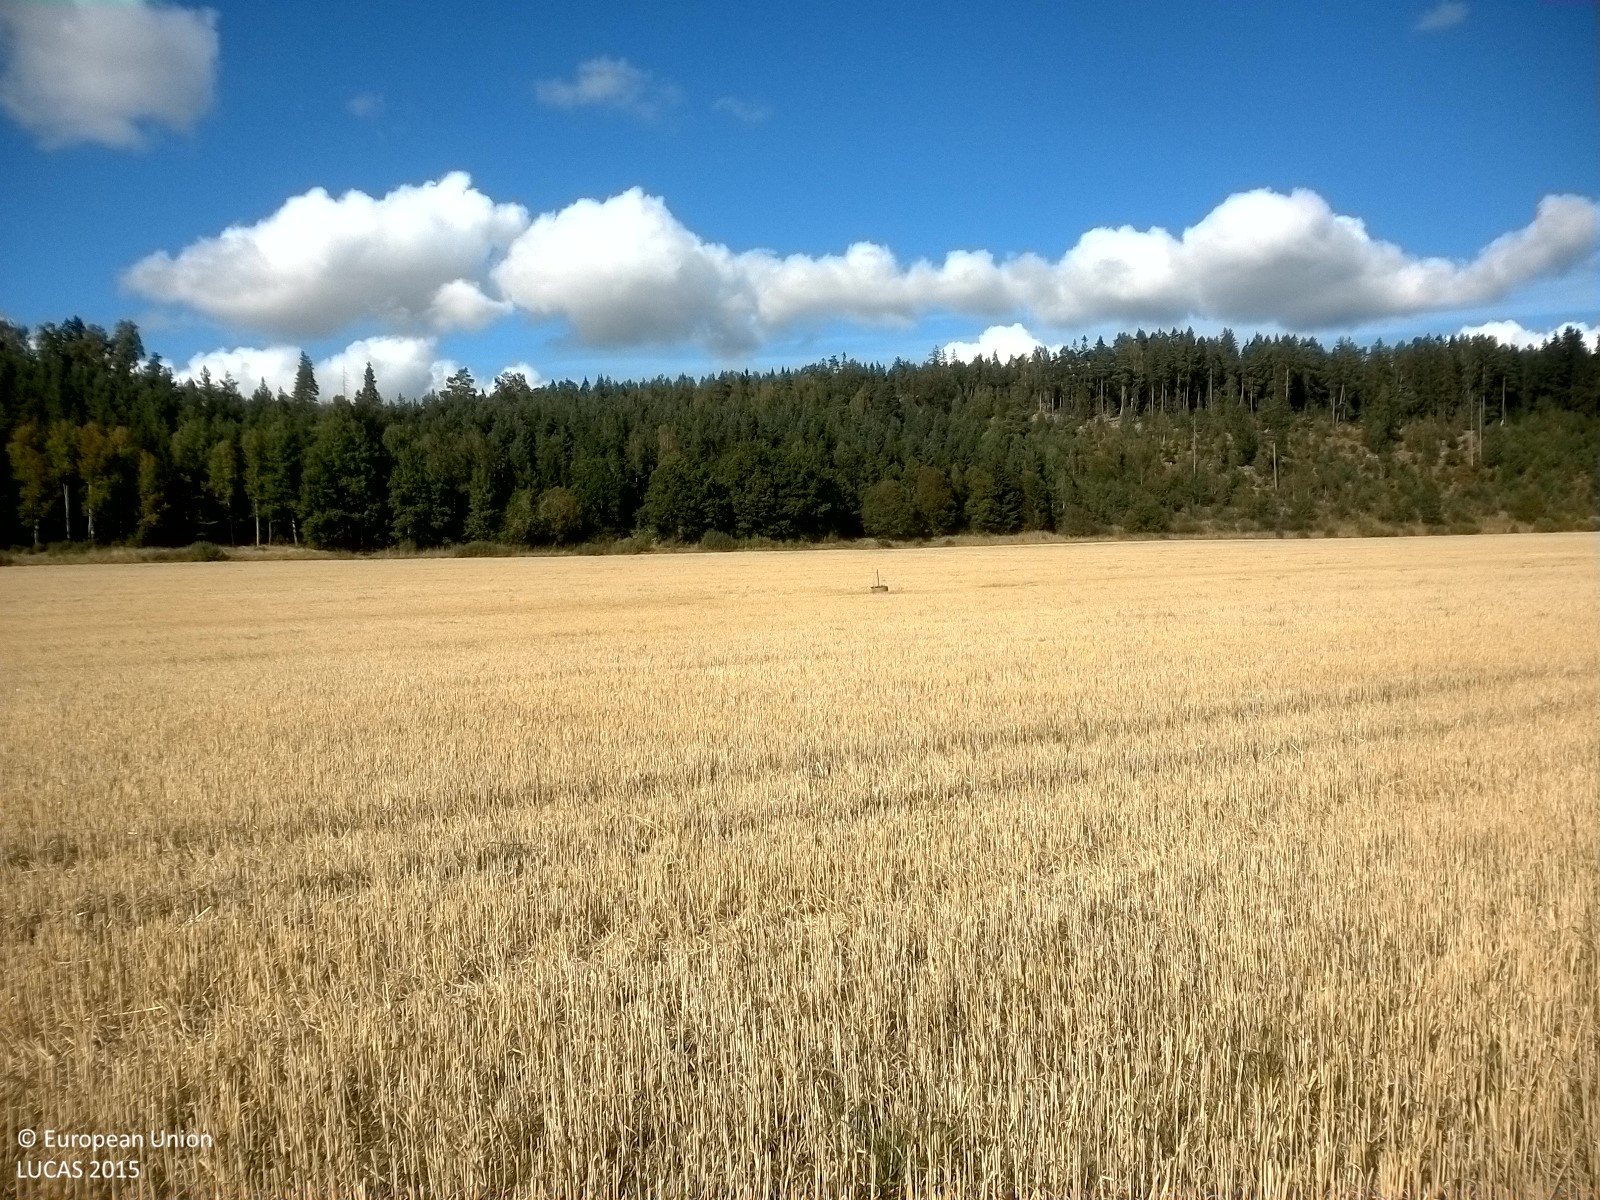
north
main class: Cropland
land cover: Common wheat
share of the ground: > 75 %
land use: Agriculture (excluding fallow land and kitchen gardens)
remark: Harvested field
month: September
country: SE
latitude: 58.4826
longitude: 16.3931
